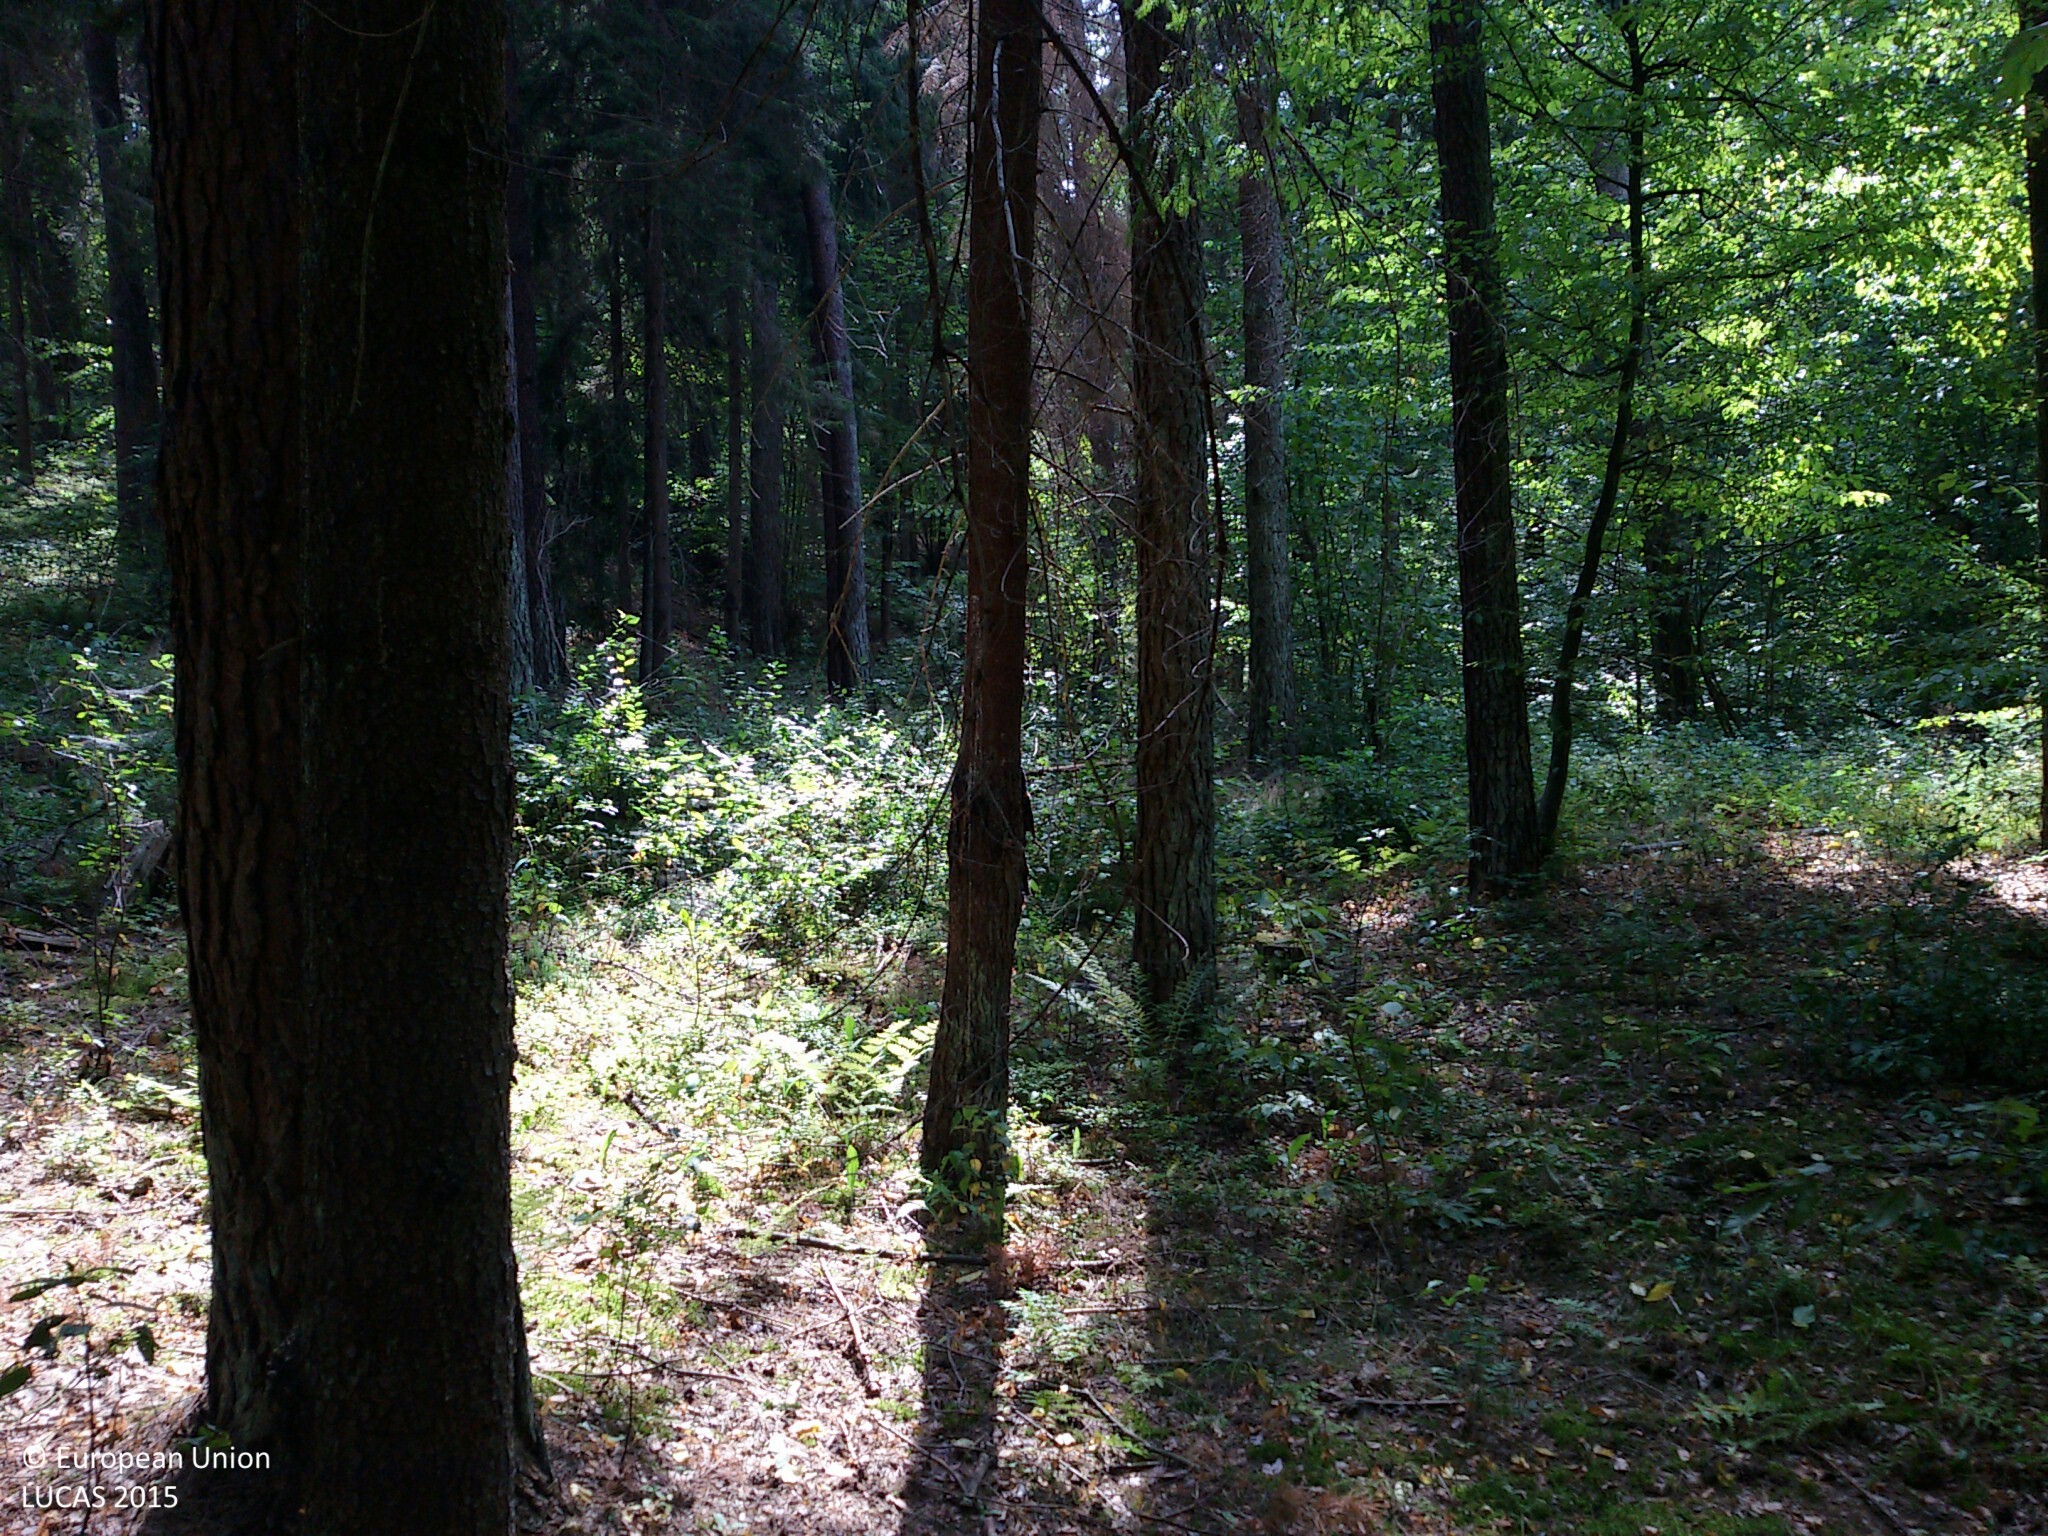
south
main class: Woodland
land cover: Pine dominated mixed woodland
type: hemiboreal forest and nemoral coniferous forest and mixed broadleaved-coniferous forest
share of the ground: > 75 %
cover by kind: coniferous forest trees 65 %, broadleaved forest trees 25 %, herbaceous plants 5 %, unconsolidated bare surface 5 %
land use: Forestry
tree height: > 5 m
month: August
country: PL
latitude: 53.5712
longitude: 20.1660
